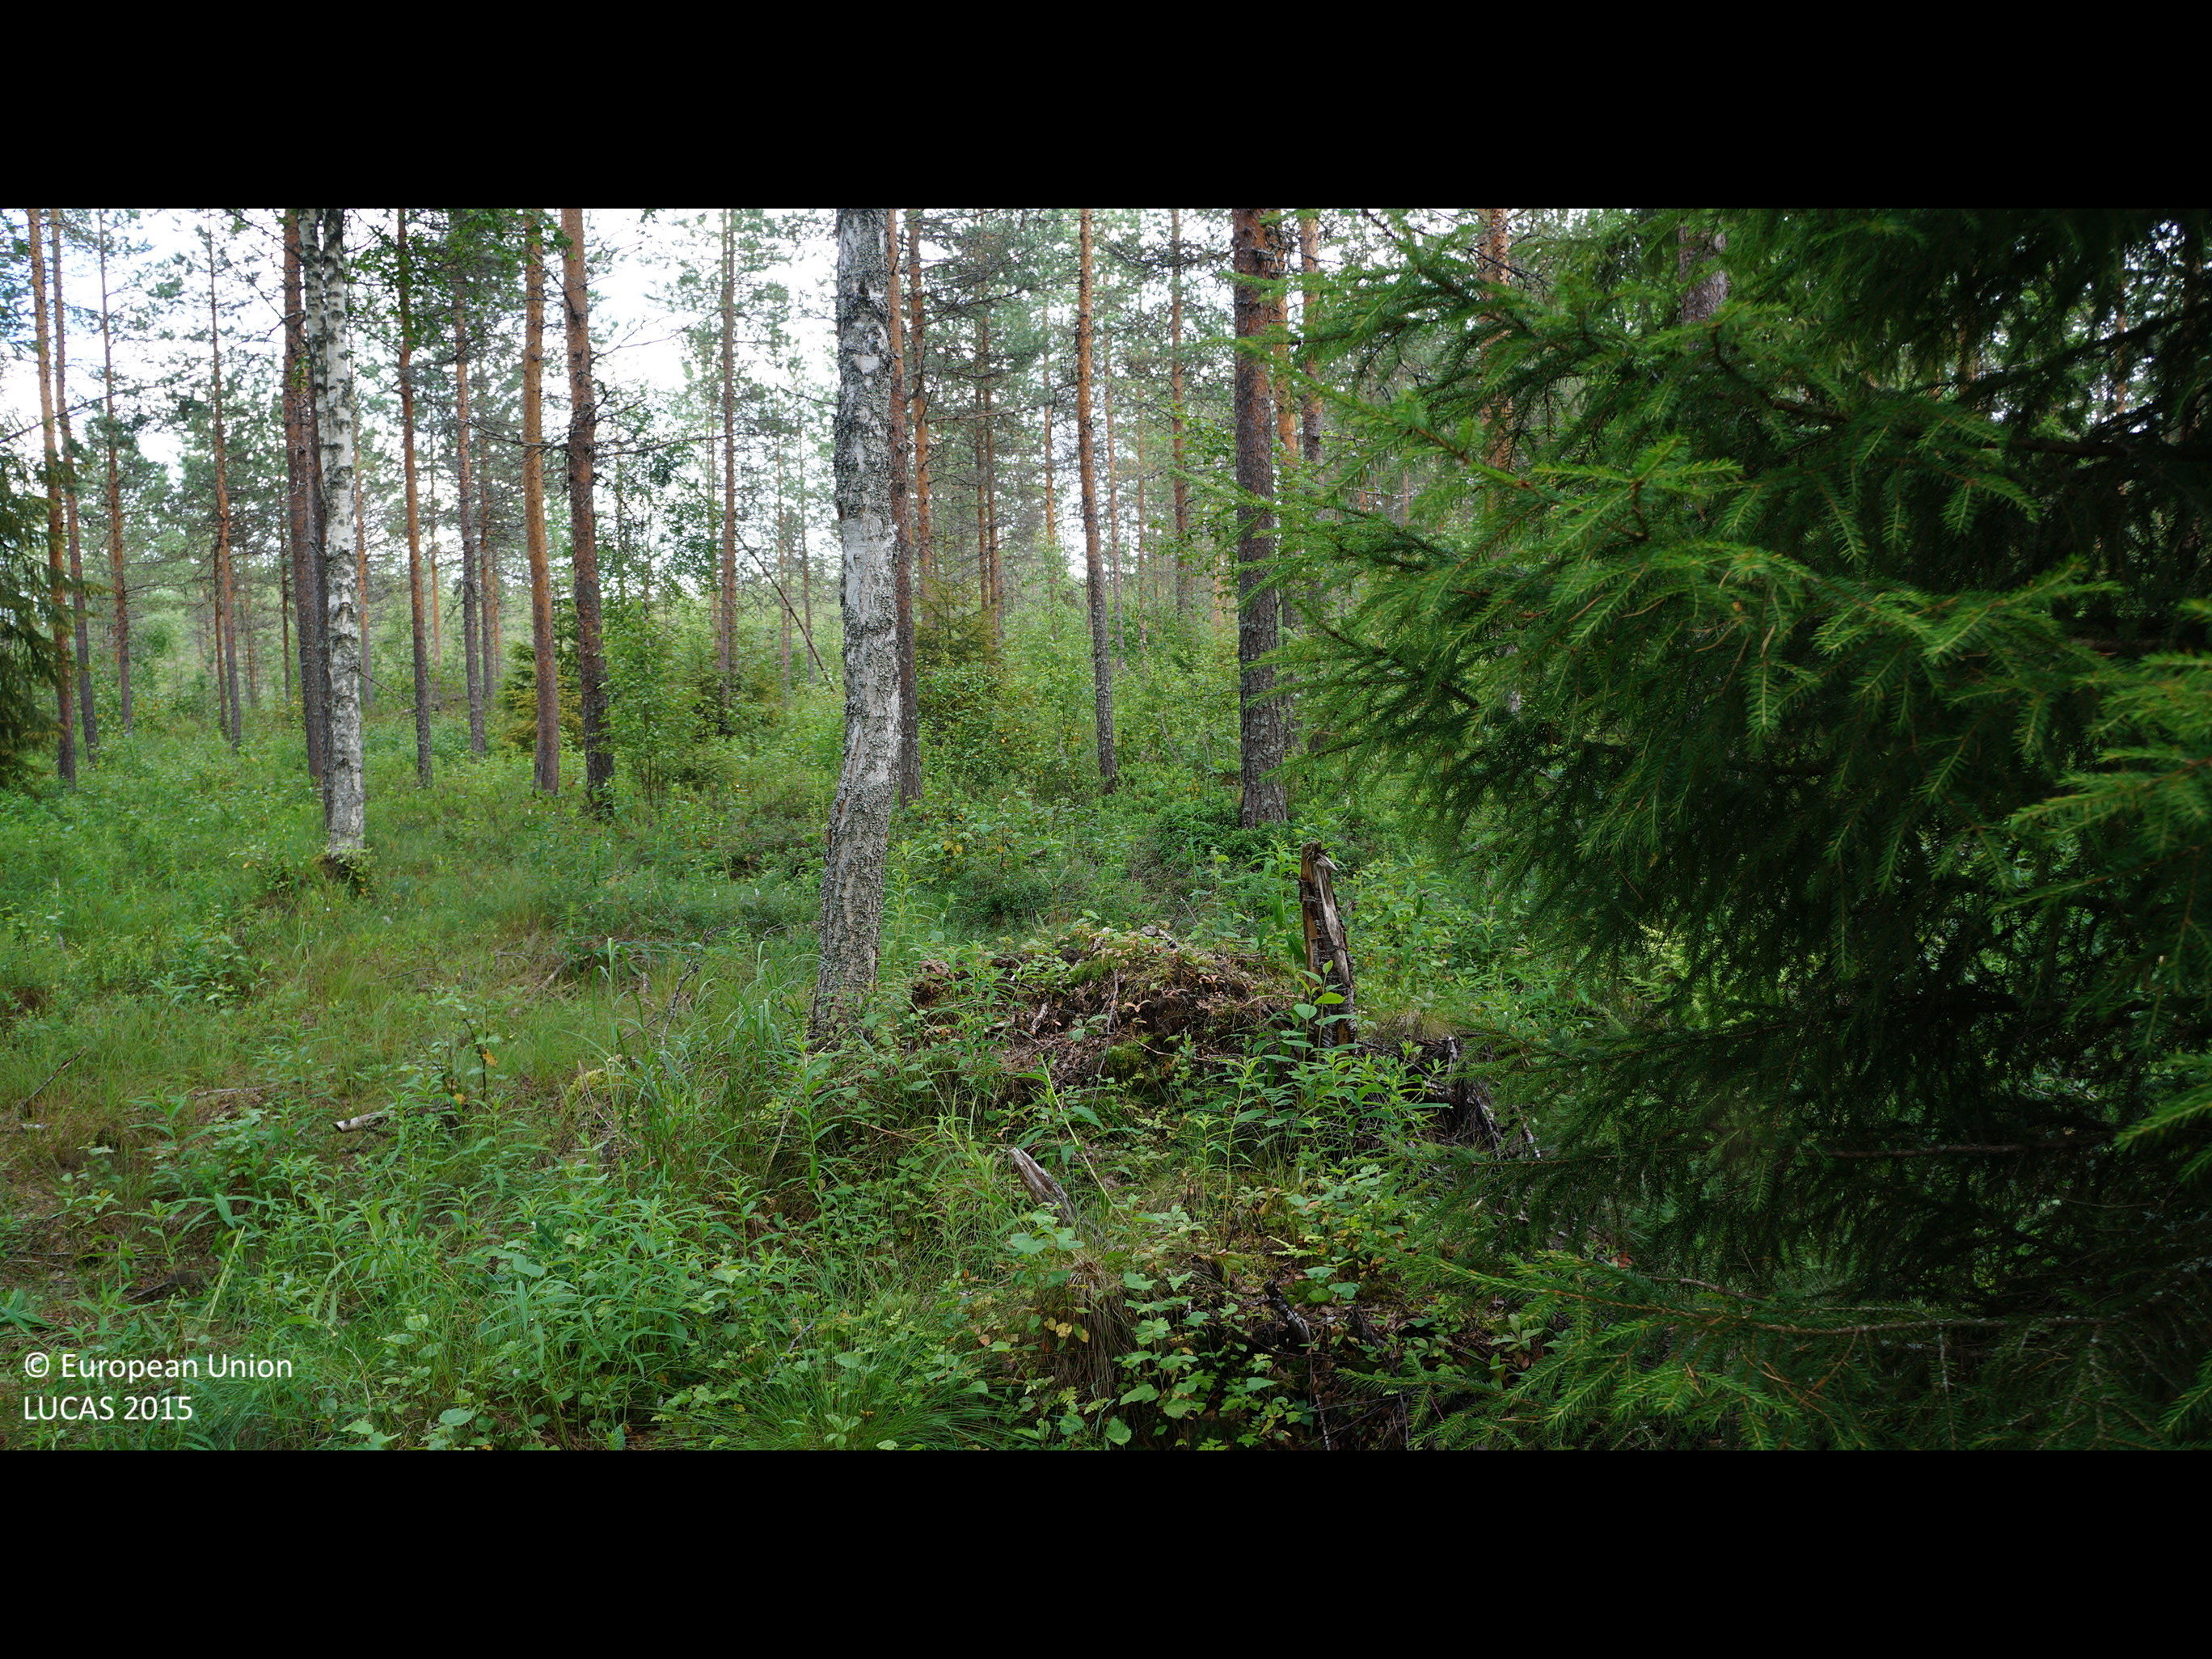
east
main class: Woodland
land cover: Pine dominated mixed woodland
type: boreal forest
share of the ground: 50 - 75 %
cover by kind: coniferous forest trees 30 %, herbaceous plants 30 %, broadleaved forest trees 20 %, shrubs 20 %
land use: Forestry
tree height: > 5 m
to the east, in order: Pine dominated mixed woodland; Pine dominated coniferous woodland; Ditches and canals; Pine dominated coniferous woodland; Ditches and canals; Pine dominated coniferous woodland; Ditches and canals
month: July
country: FI
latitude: 64.0157
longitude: 24.3717
